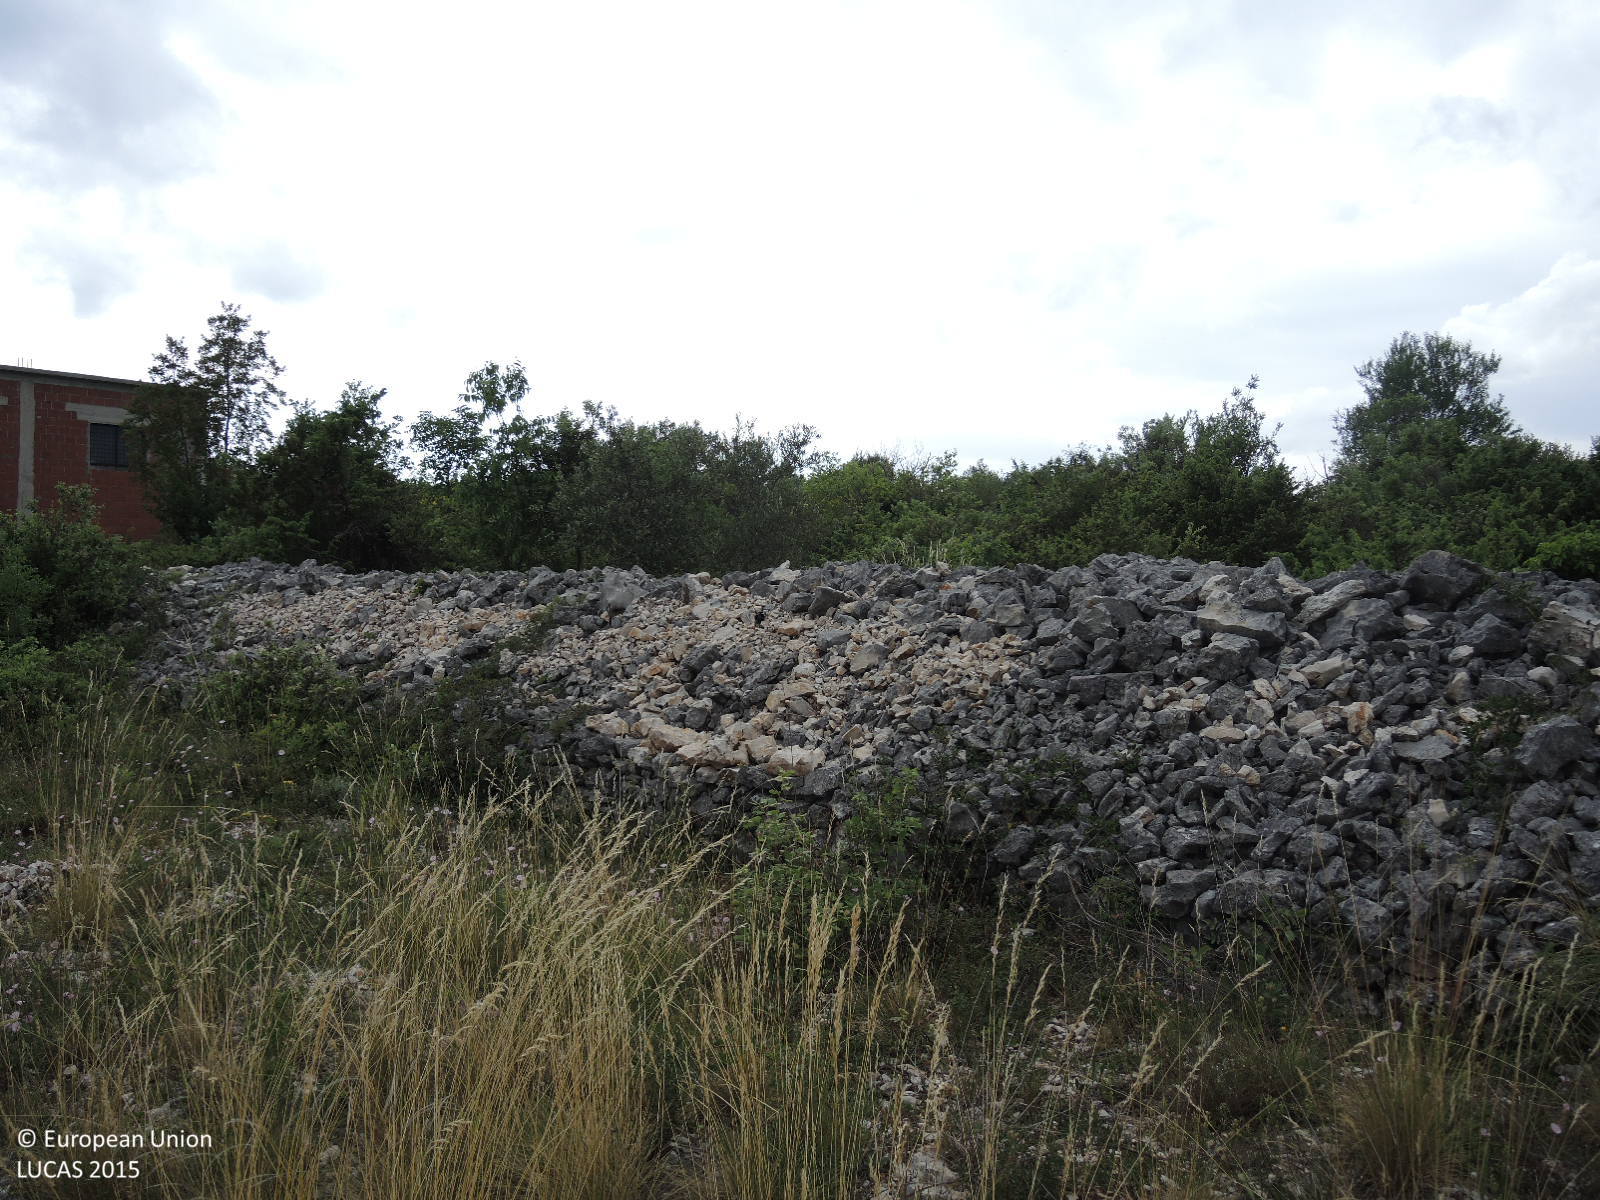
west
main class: Cropland
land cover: Olive groves
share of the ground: 10 - 25 %
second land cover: Spontaneously vegetated surfaces
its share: > 75 %
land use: Agriculture (excluding fallow land and kitchen gardens)
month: May
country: HR
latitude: 43.8088
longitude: 15.7965
